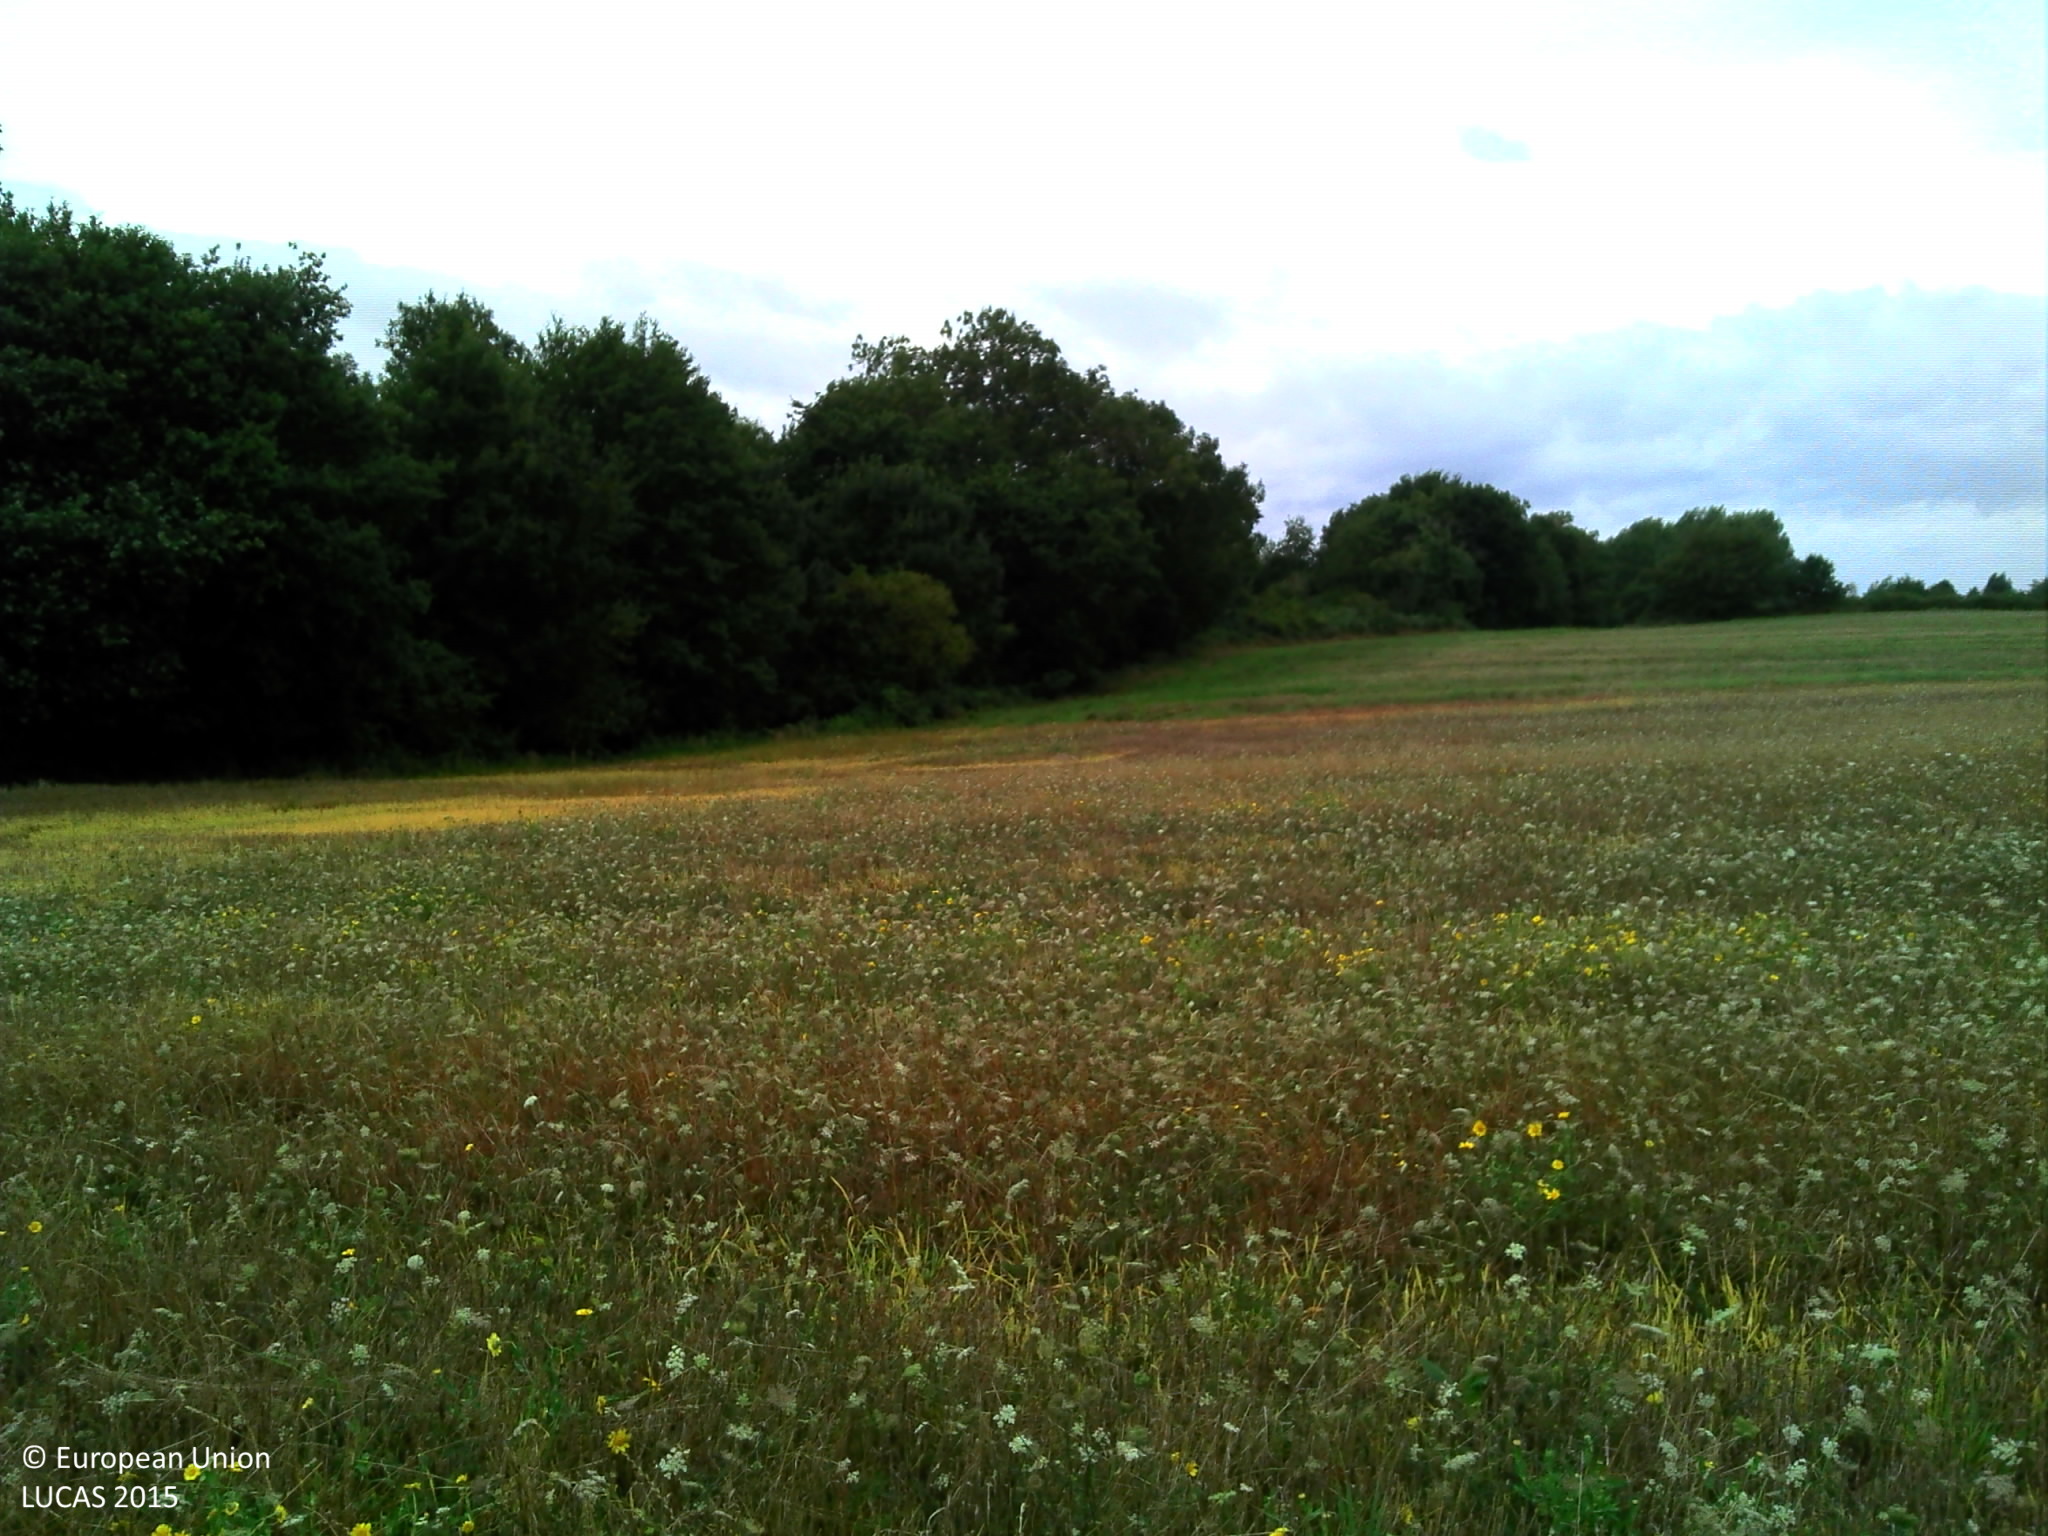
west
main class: Grassland
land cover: Spontaneously vegetated surfaces
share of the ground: > 75 %
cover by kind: herbaceous plants 100 %
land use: Fallow land
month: August
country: FR
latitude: 48.5872
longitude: -2.1356
